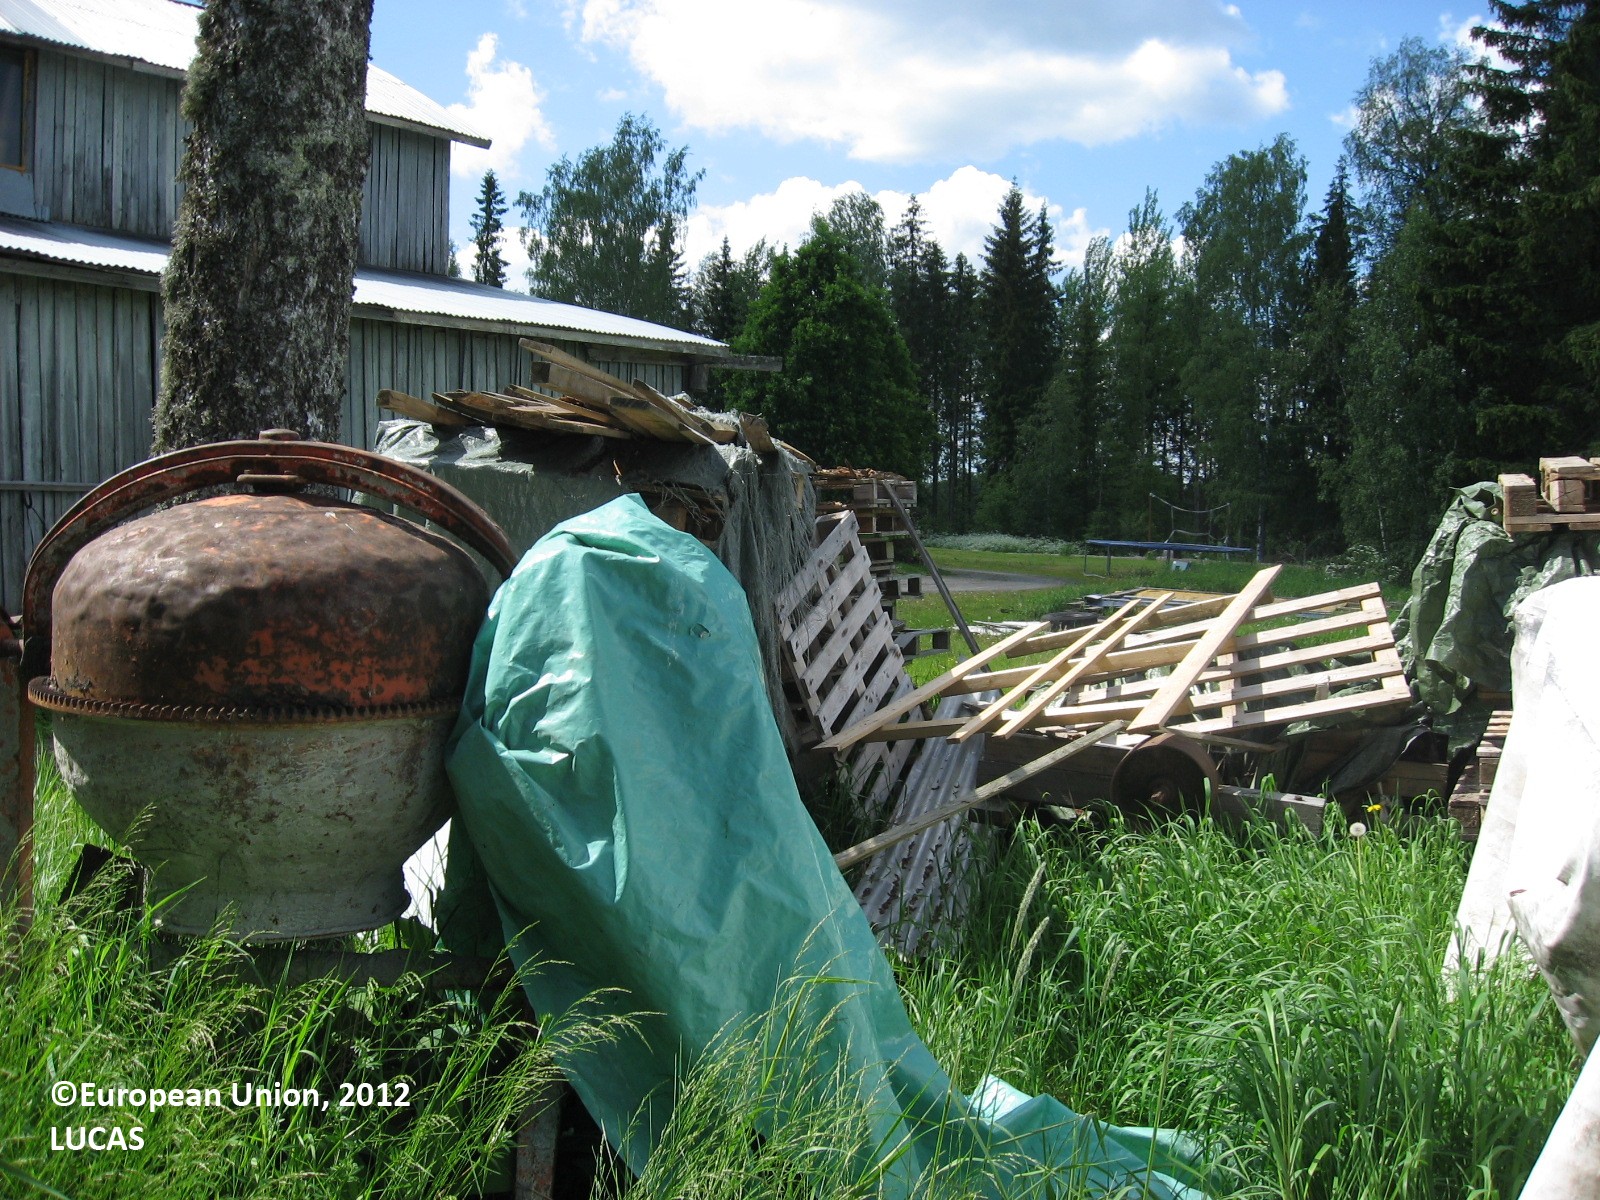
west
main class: Grassland
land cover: Grassland with sparse tree/shrub cover
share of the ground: > 75 %
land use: Residential
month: June
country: FI
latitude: 60.5220
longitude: 25.4118
